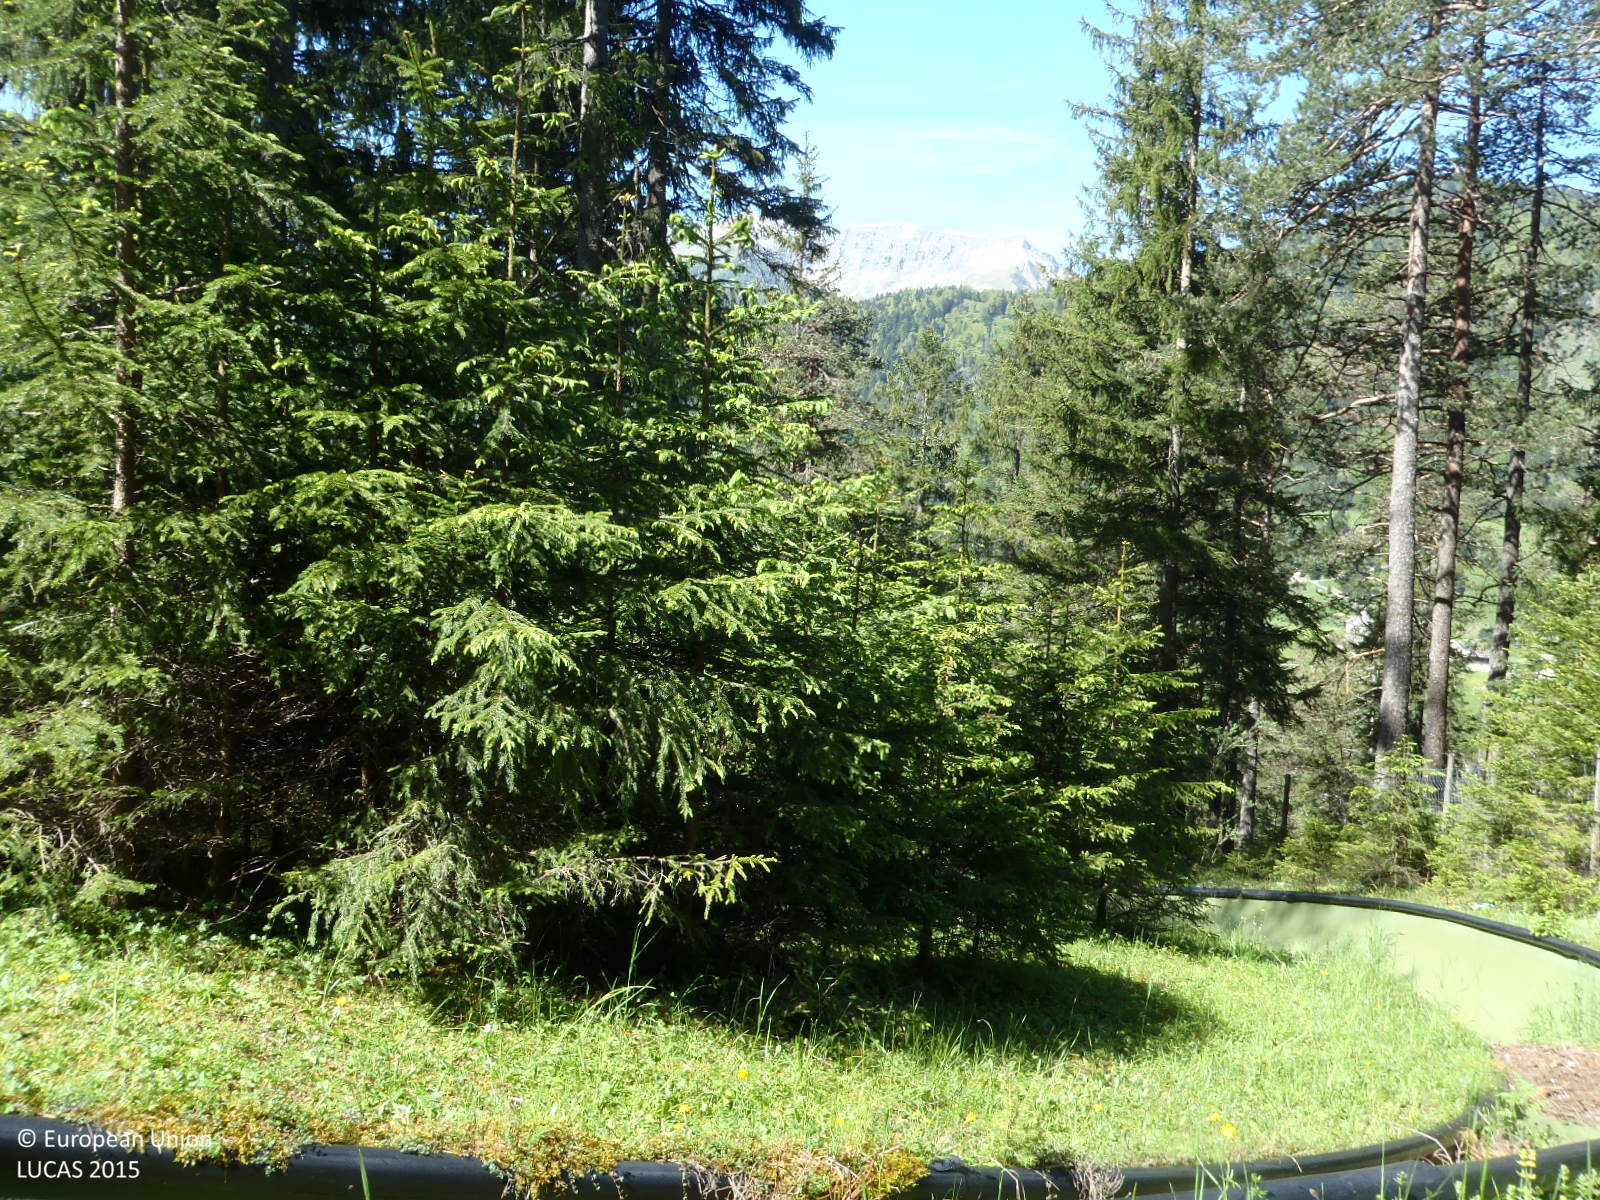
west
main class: Woodland
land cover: Pine dominated coniferous woodland
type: alpine coniferous forest
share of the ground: > 75 %
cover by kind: coniferous forest trees 90 %, herbaceous plants 5 %, unconsolidated bare surface 5 %
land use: Forestry
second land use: Agriculture (excluding fallow land and kitchen gardens)
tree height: > 5 m
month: May
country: AT
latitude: 47.5262
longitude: 11.7120
